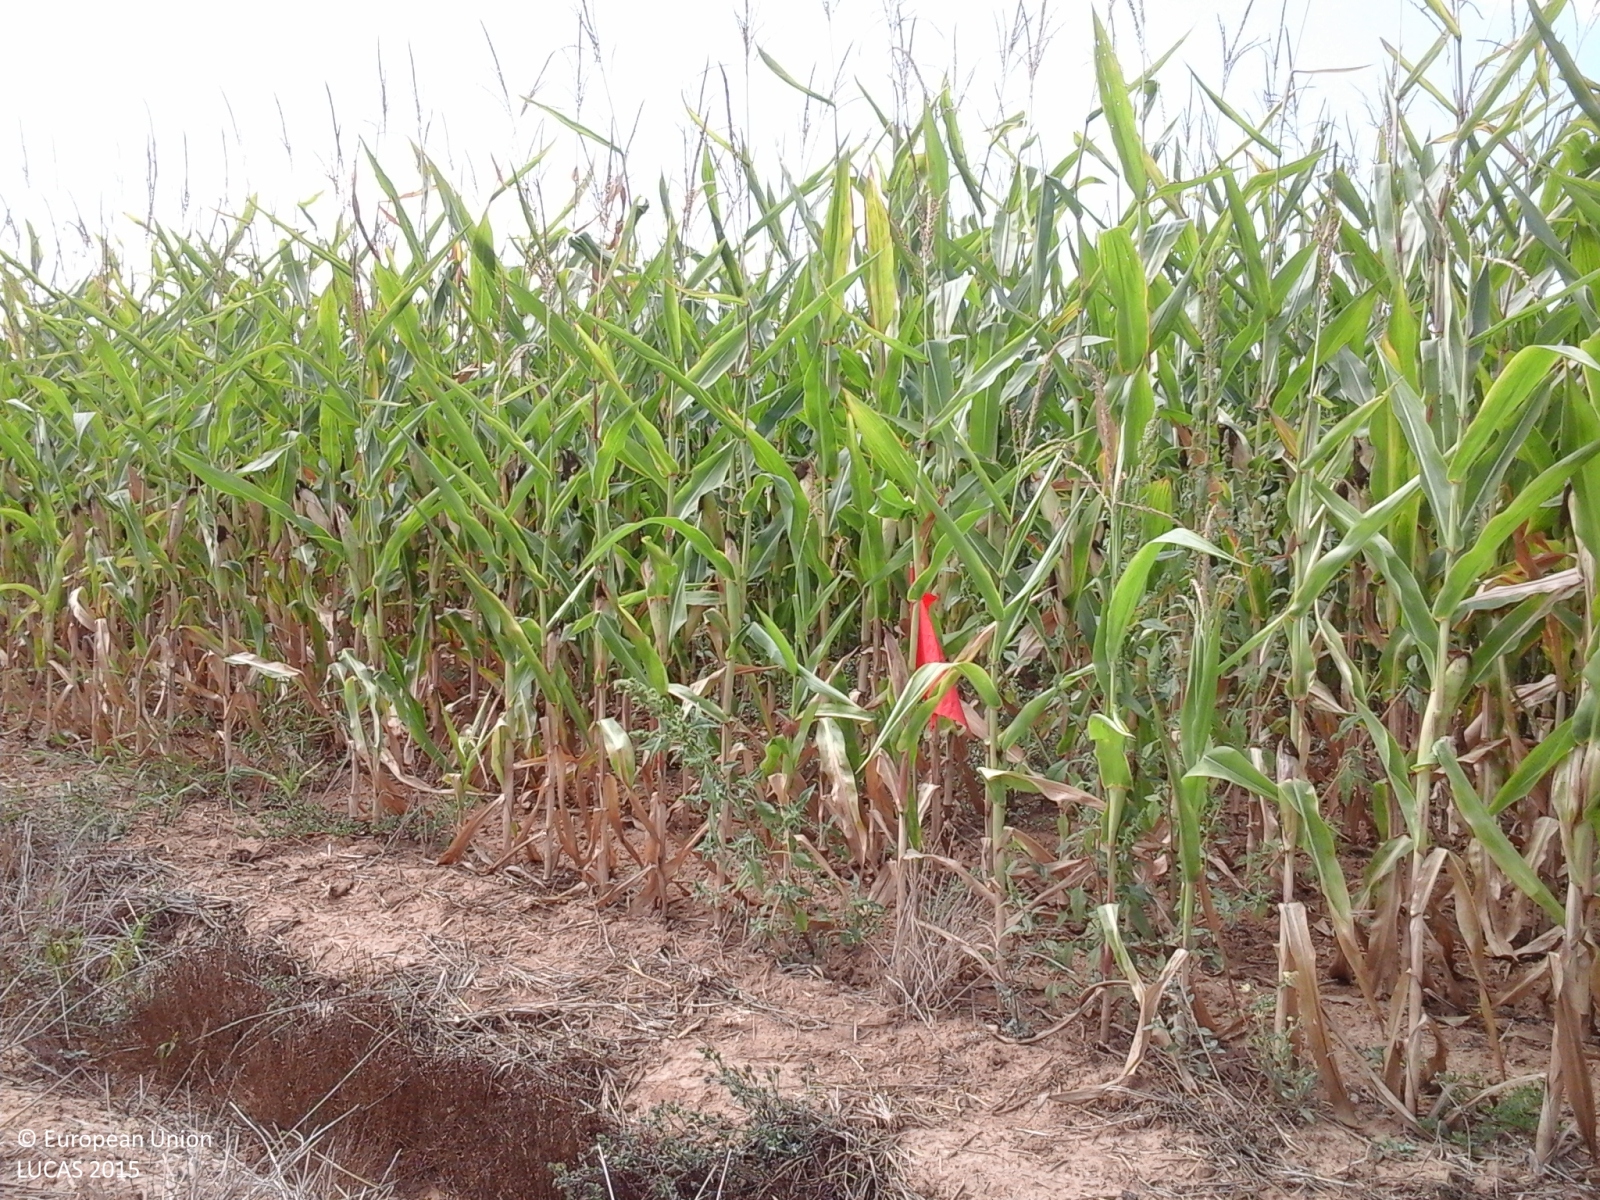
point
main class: Cropland
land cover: Maize
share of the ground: > 75 %
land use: Agriculture (excluding fallow land and kitchen gardens)
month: August
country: IT
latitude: 42.7022
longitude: 11.1072
